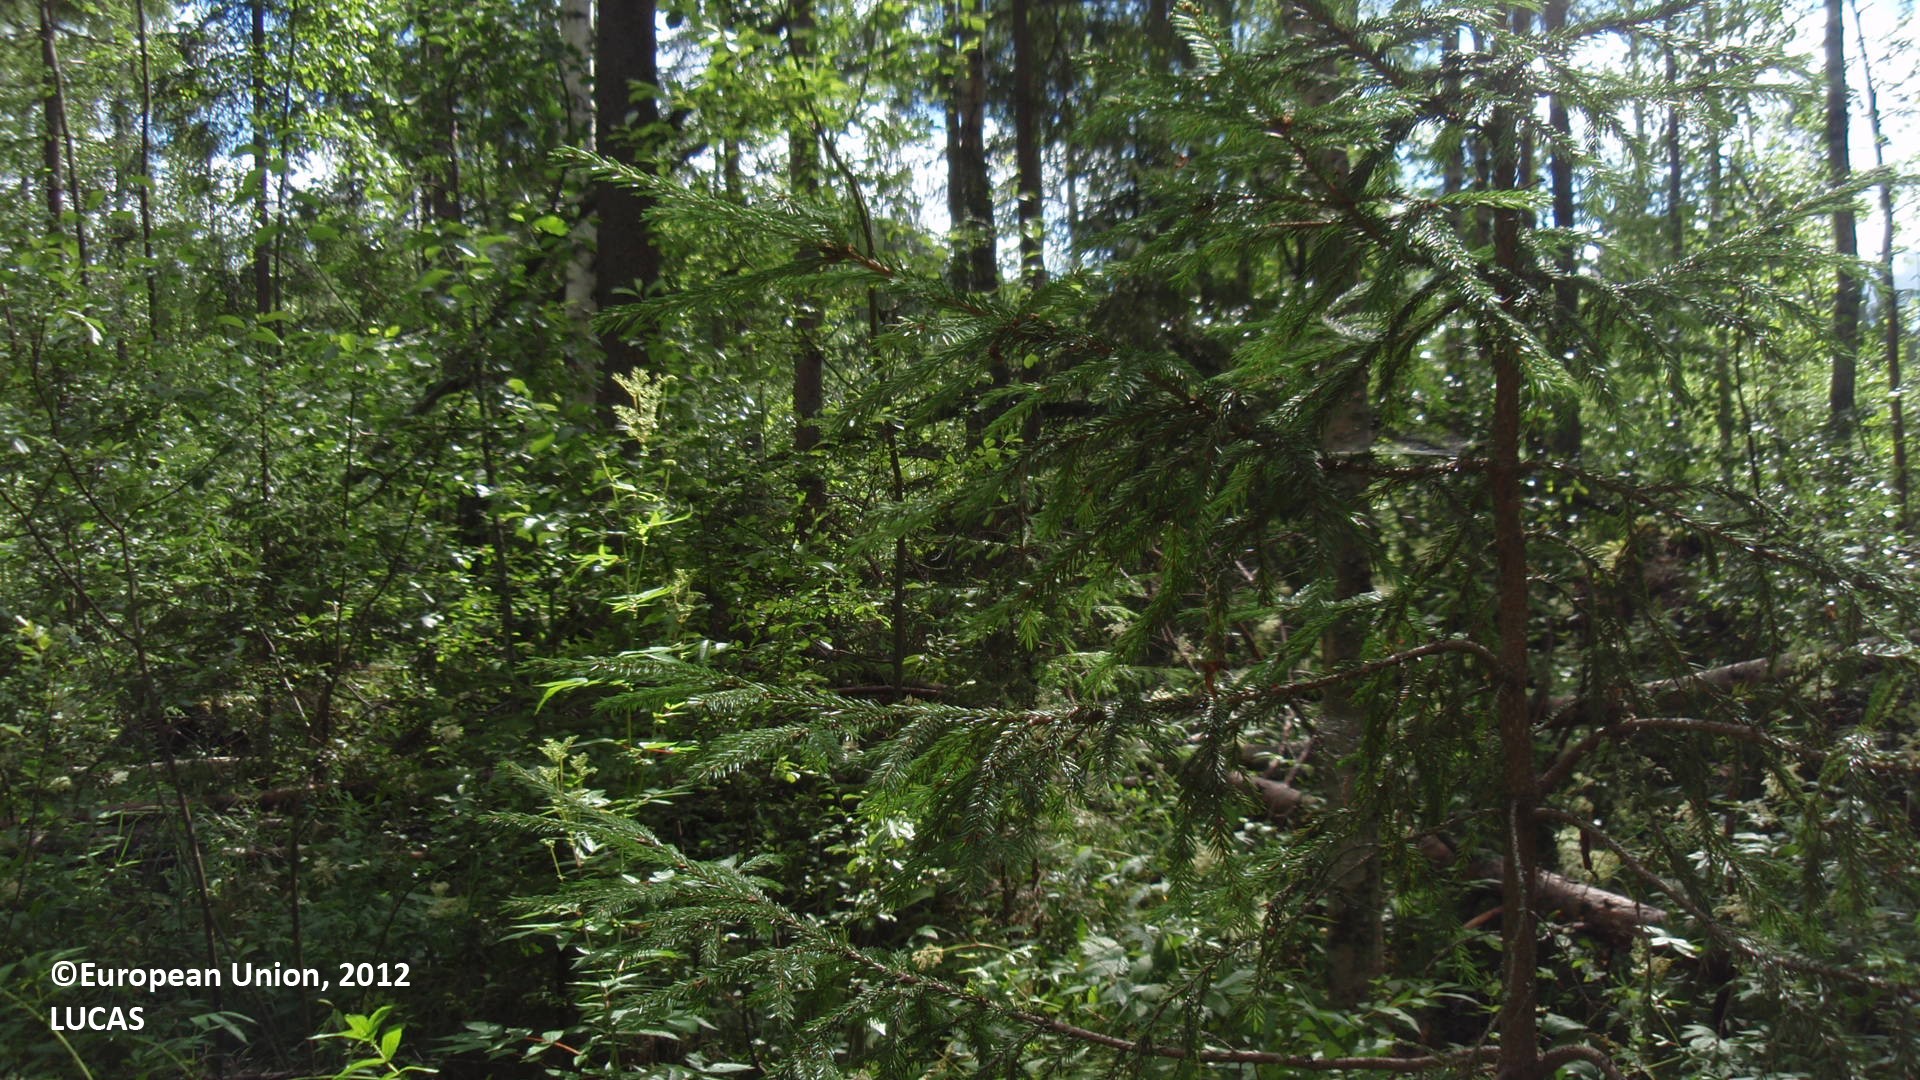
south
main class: Woodland
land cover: Spruce dominated mixed woodland
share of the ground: 50 - 75 %
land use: Forestry
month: July
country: FI
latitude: 61.6371
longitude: 27.4402
